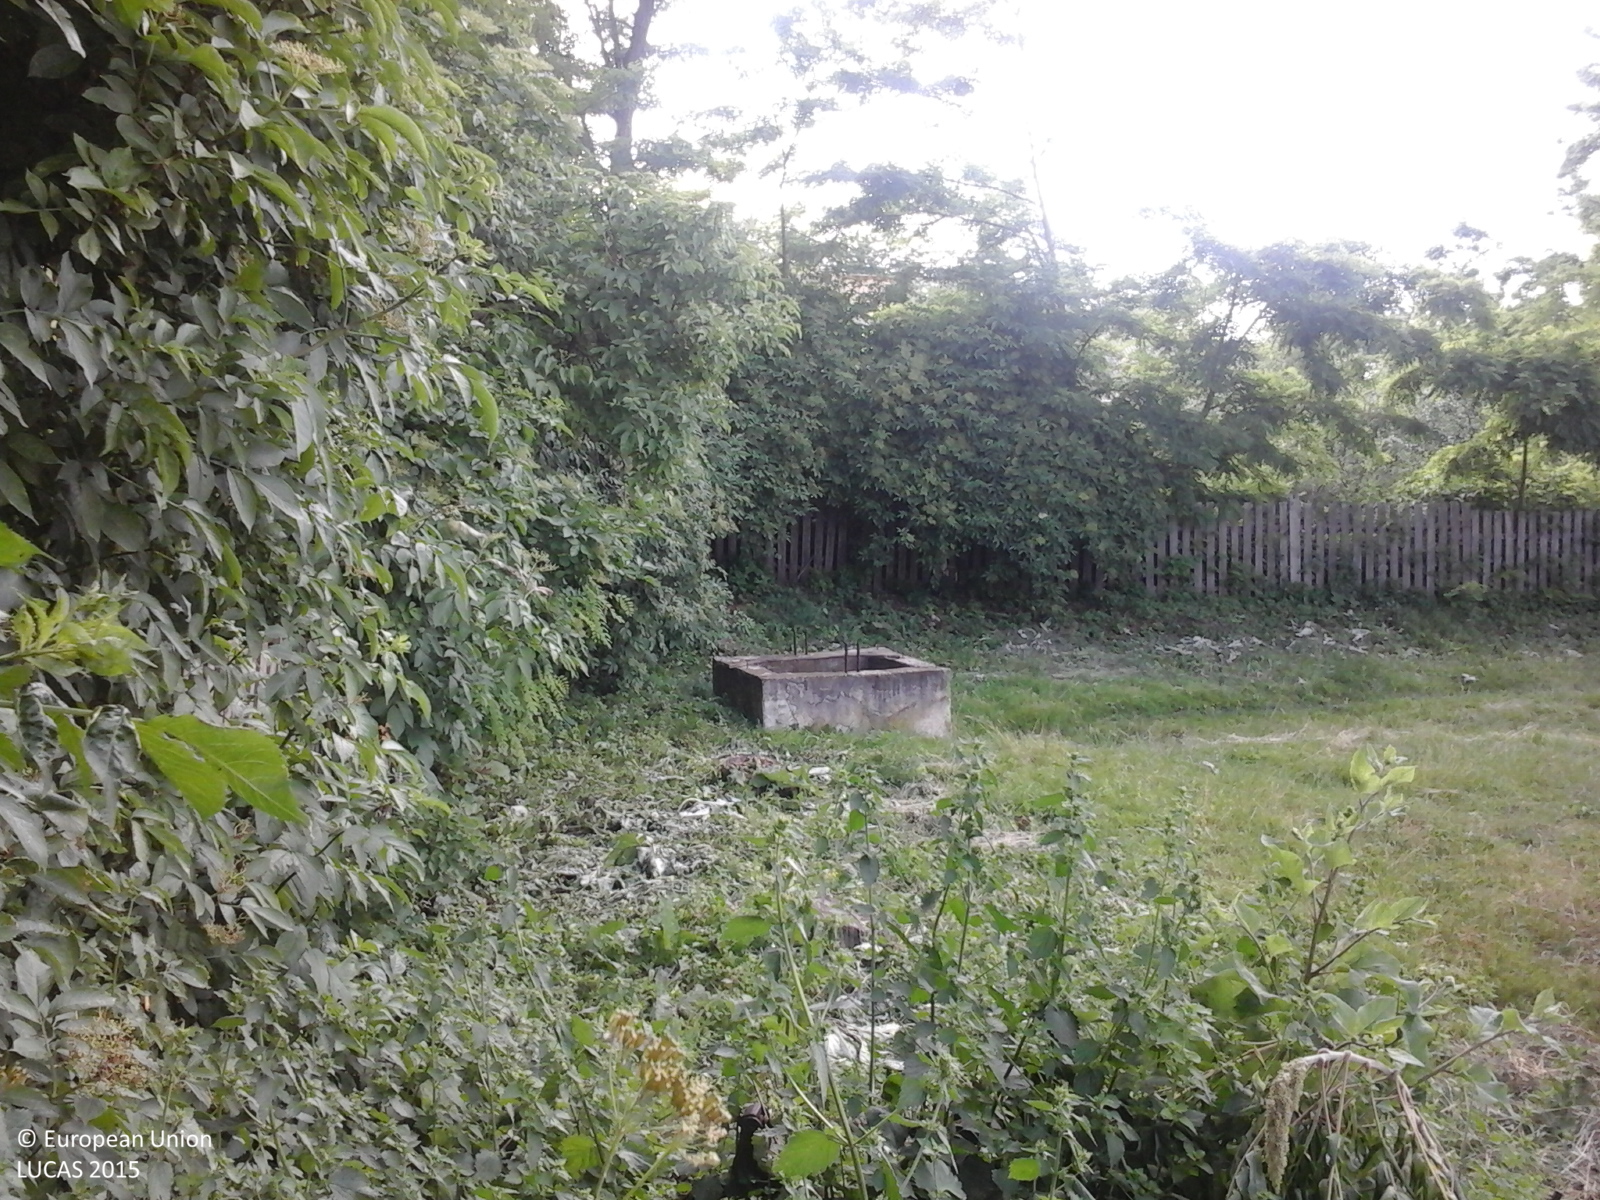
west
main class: Cropland
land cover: Maize
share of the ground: > 75 %
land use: Agriculture (excluding fallow land and kitchen gardens)
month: June
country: RO
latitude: 47.5935
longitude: 26.3771
